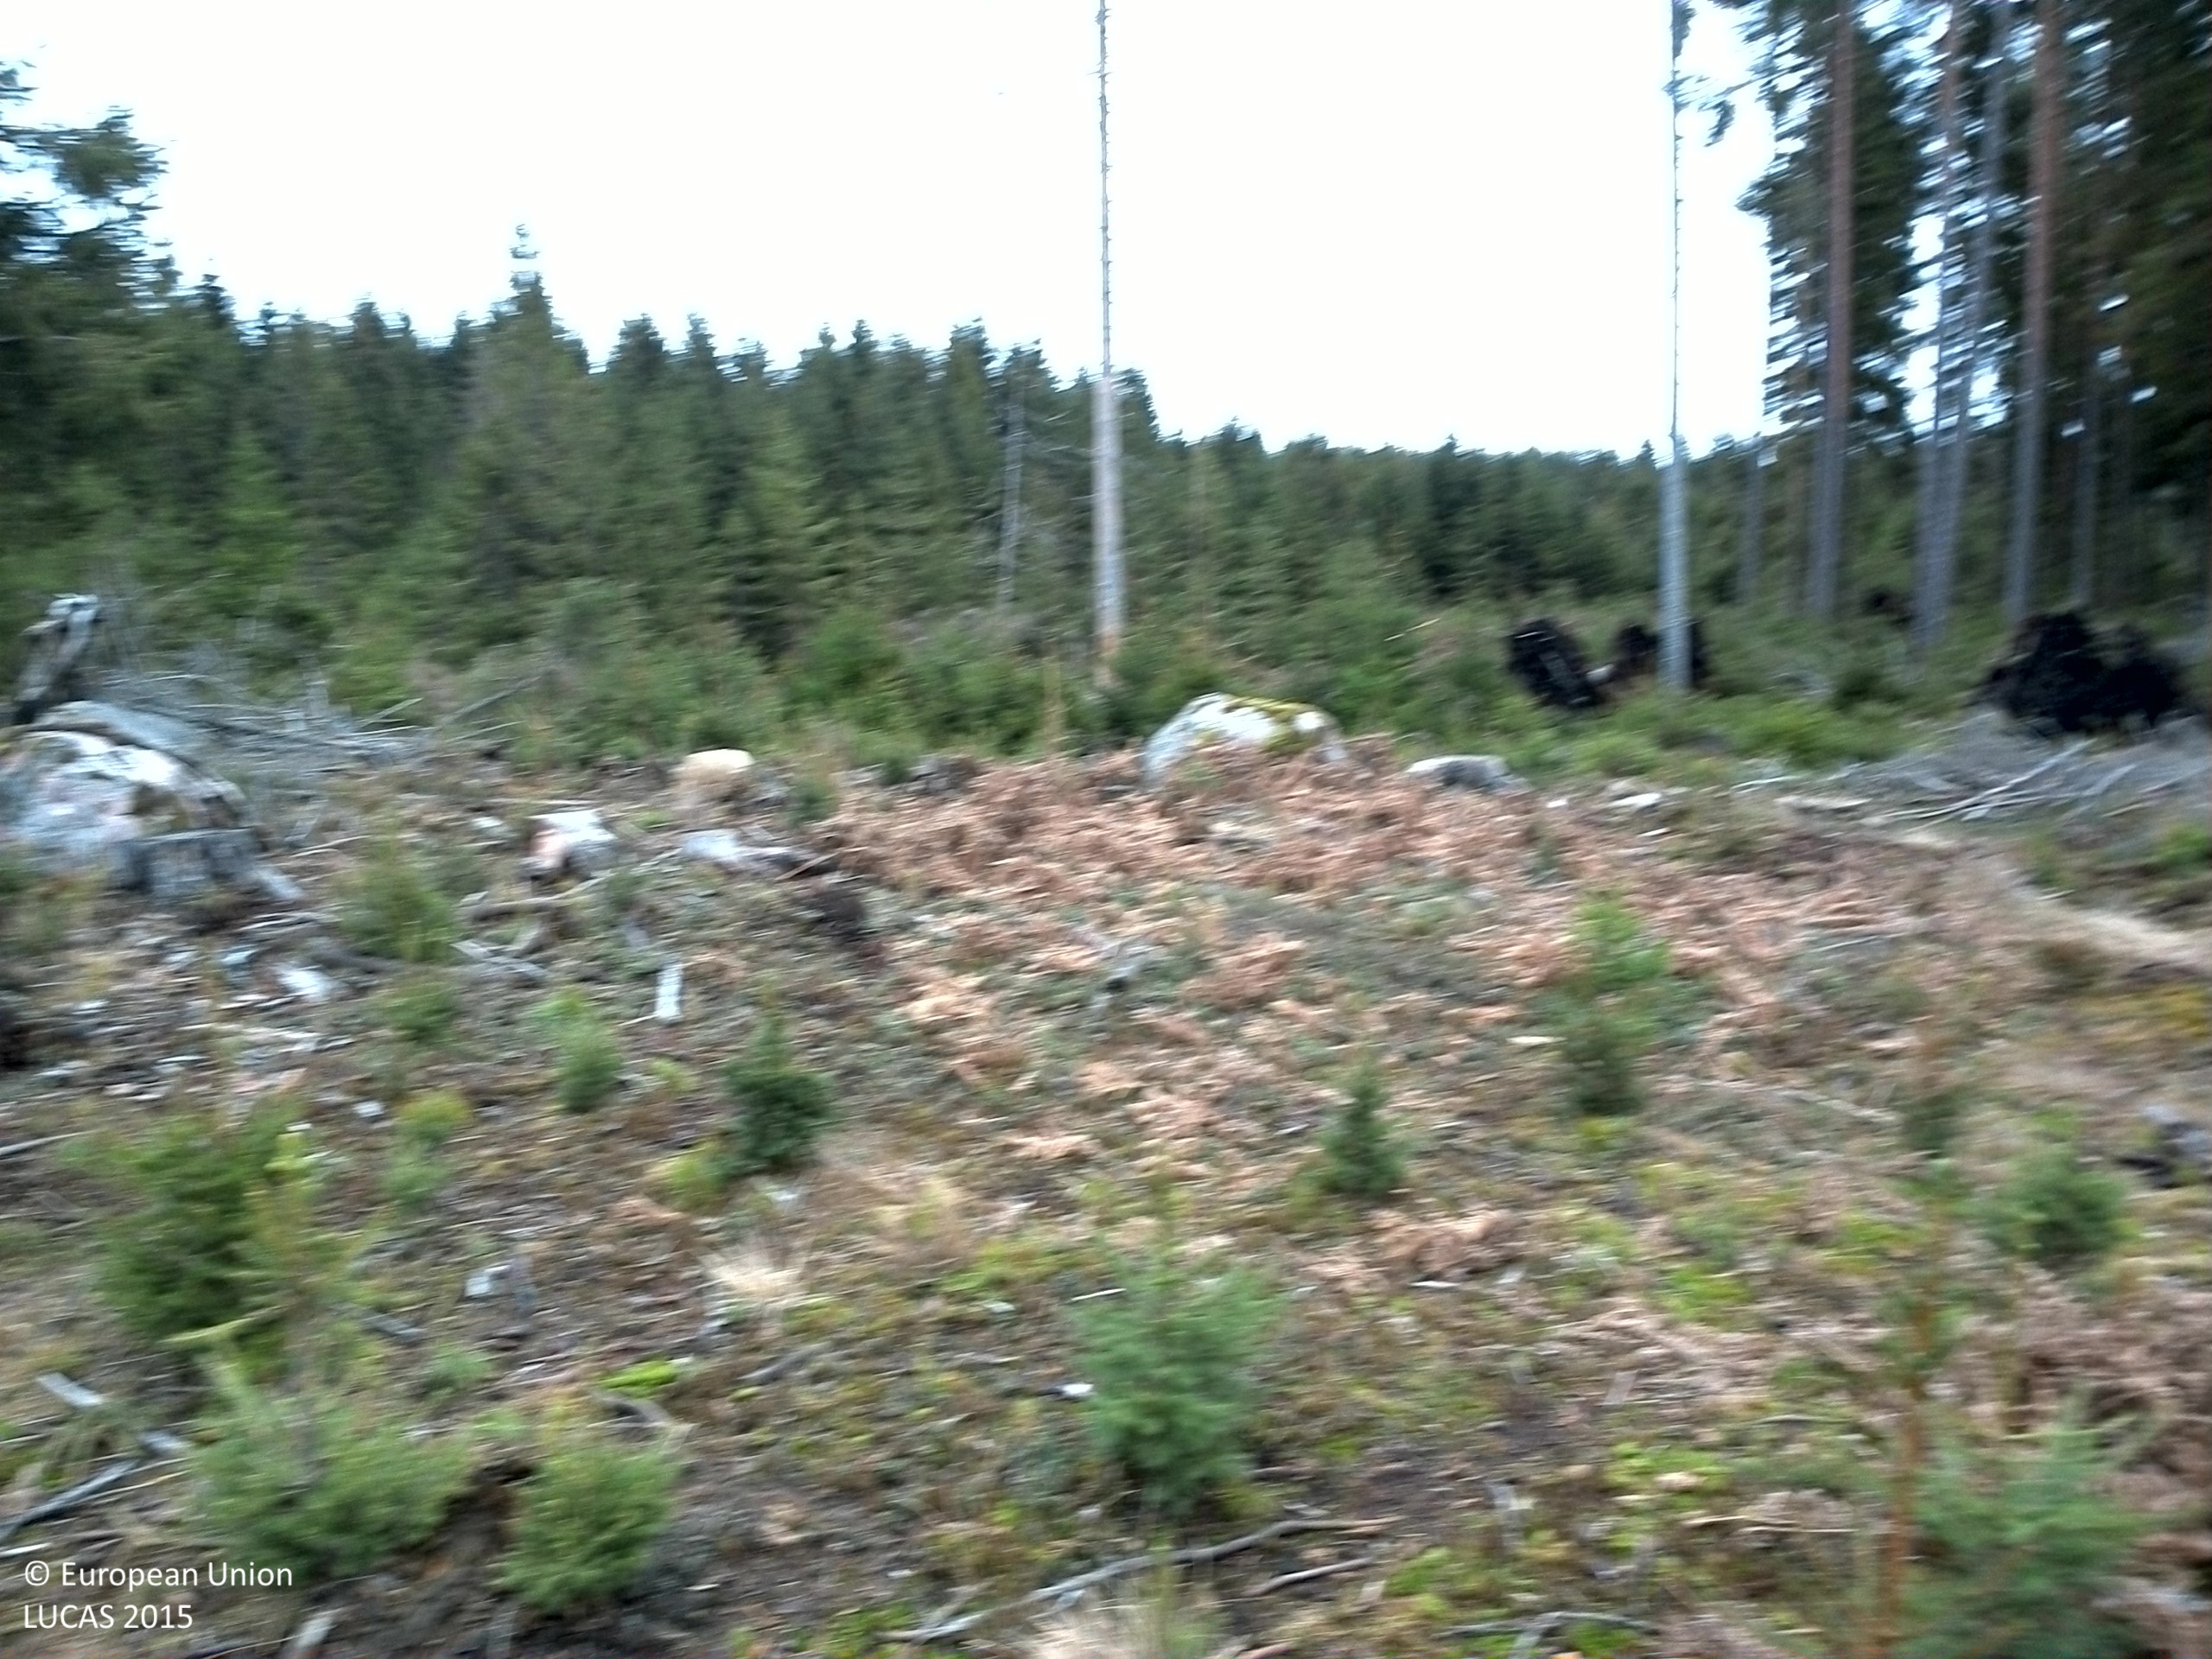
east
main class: Woodland
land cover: Spruce dominated coniferous woodland
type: boreal forest
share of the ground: 10 - 25 %
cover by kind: herbaceous plants 50 %, coniferous forest trees 20 %, shrubs 10 %, lichens and mosses 10 %, unconsolidated bare surface 10 %
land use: Forestry
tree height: < 5 m
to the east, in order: Spruce dominated coniferous woodland; Ditches and canals; Spruce dominated coniferous woodland; Ditches and canals; Spruce dominated coniferous woodland; Ditches and canals; Spruce dominated coniferous woodland
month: November
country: SE
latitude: 58.9261
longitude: 16.9265
